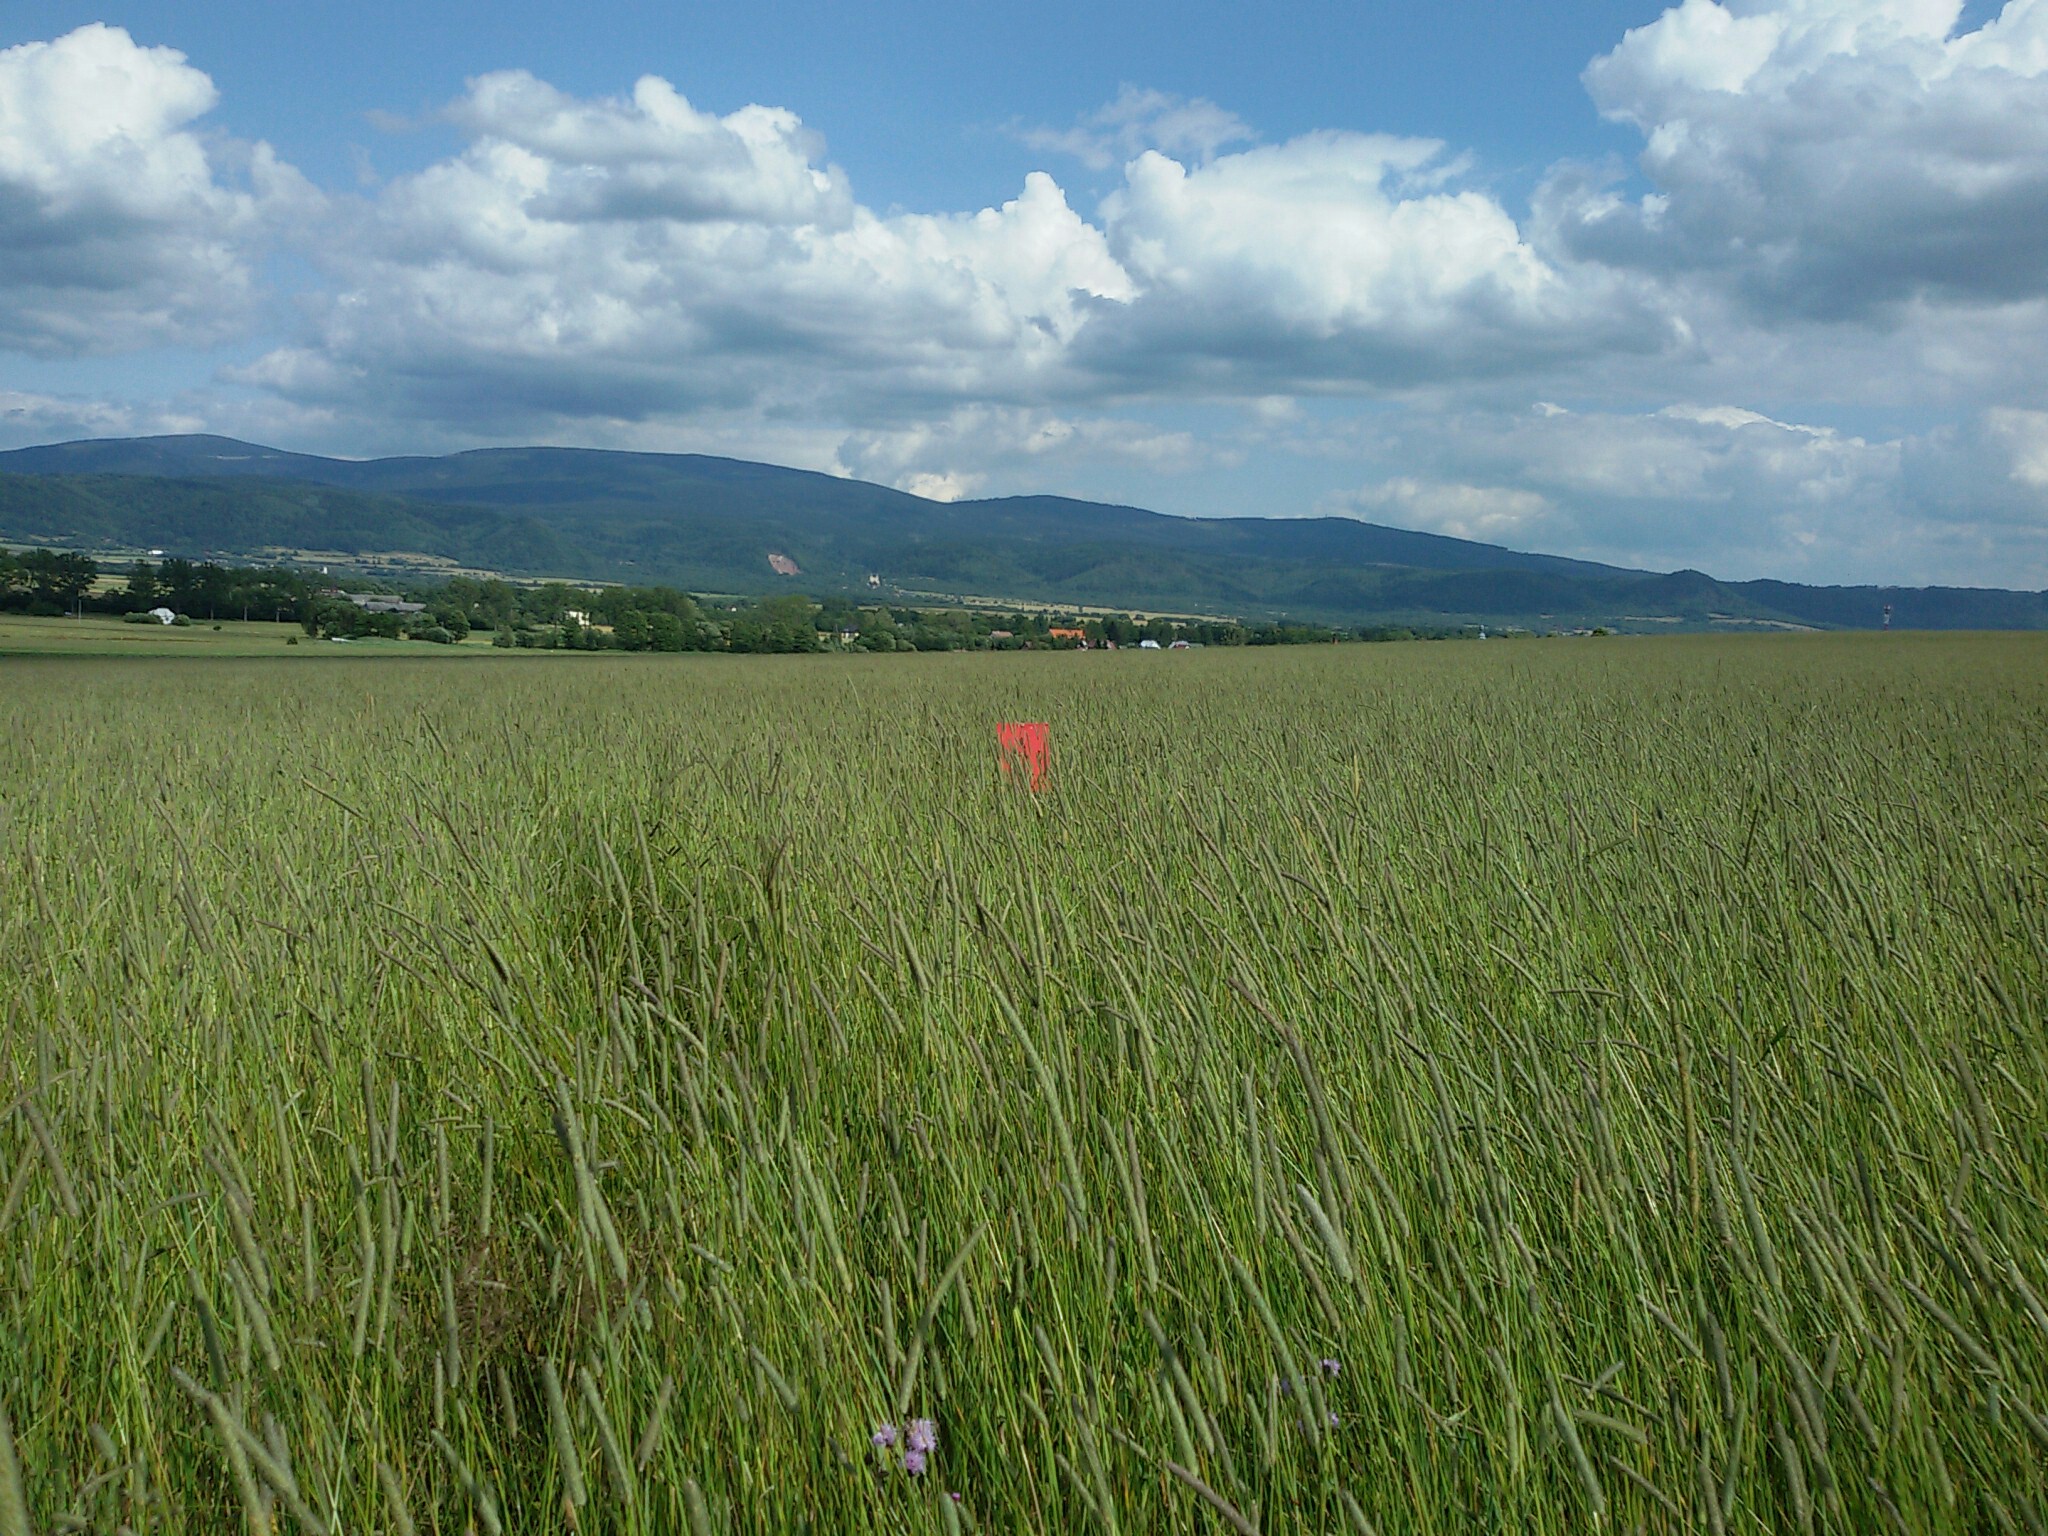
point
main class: Grassland
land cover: Grassland without tree/shrub cover
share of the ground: > 75 %
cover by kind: herbaceous plants 100 %
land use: Agriculture (excluding fallow land and kitchen gardens)
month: July
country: PL
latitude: 50.2237
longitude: 16.6661
